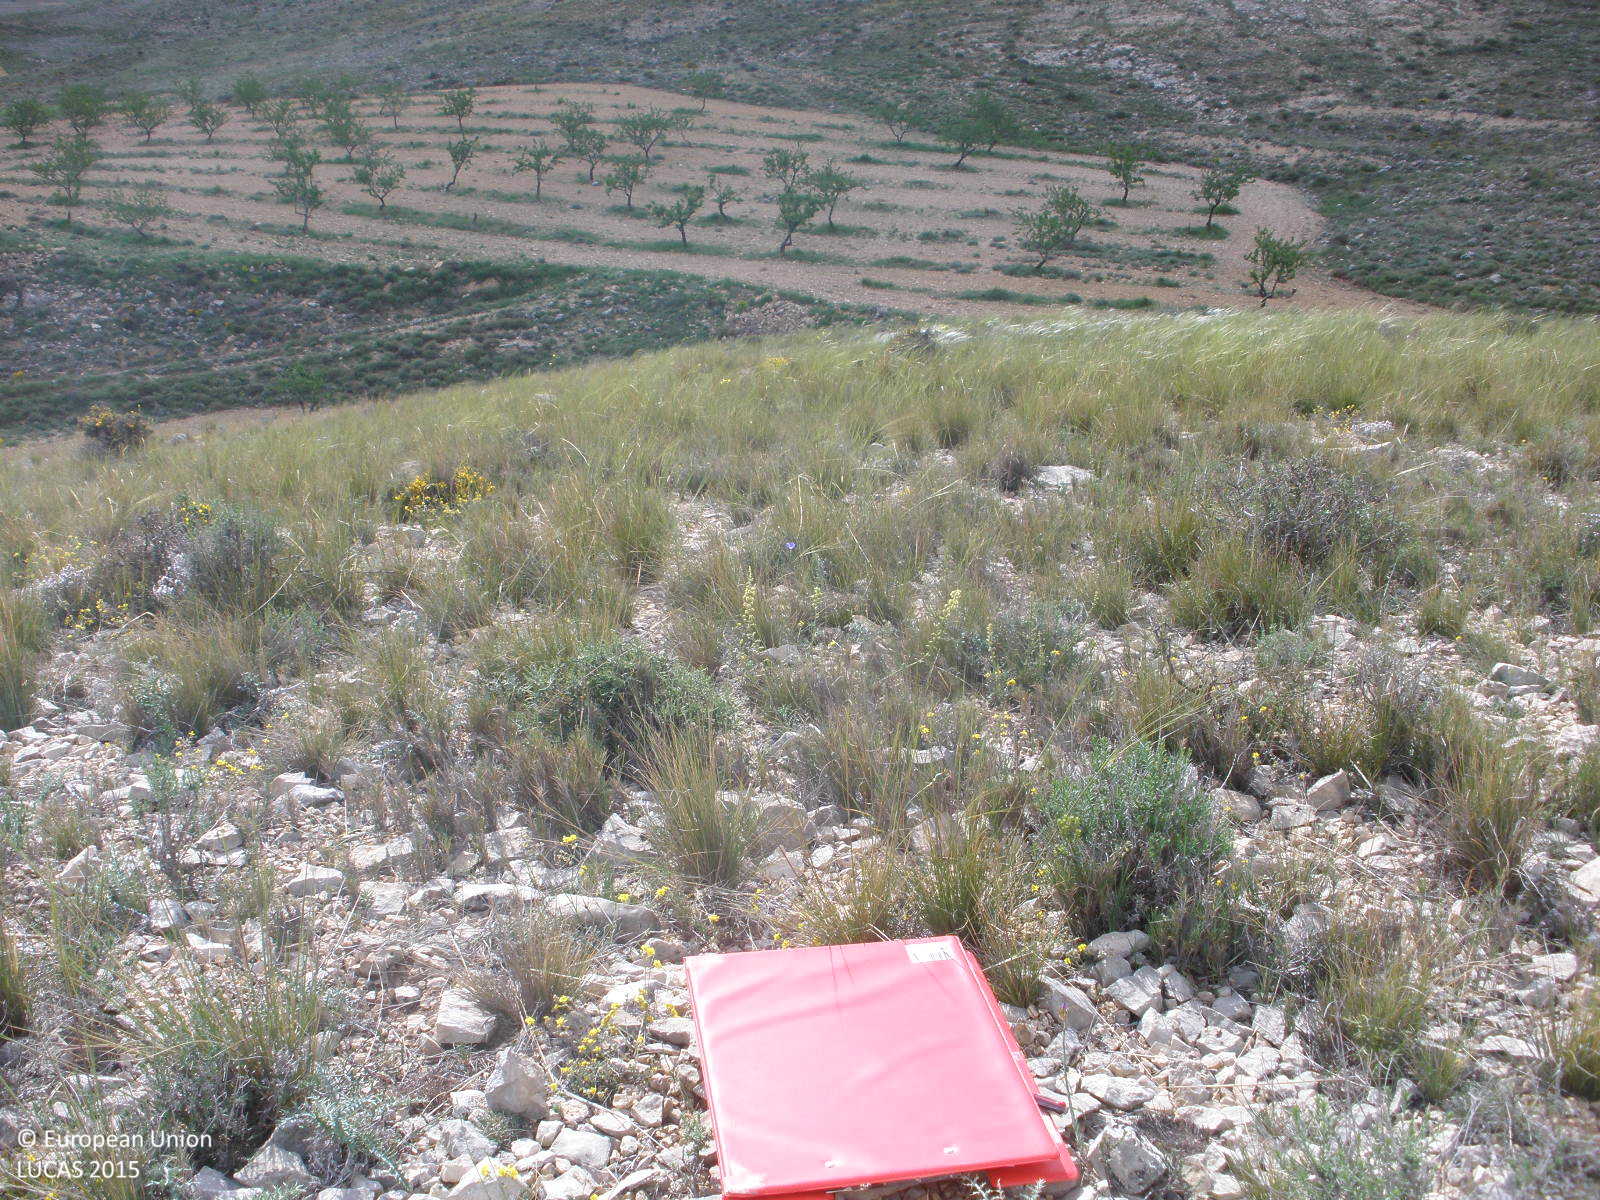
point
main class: Shrubland
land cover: Shrubland without tree cover
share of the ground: 25 - 50 %
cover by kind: herbaceous plants 40 %, shrubs 30 %, consolidated bare surface 30 %
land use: Agriculture (excluding fallow land and kitchen gardens)
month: May
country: ES
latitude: 41.0438
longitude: -0.9014
